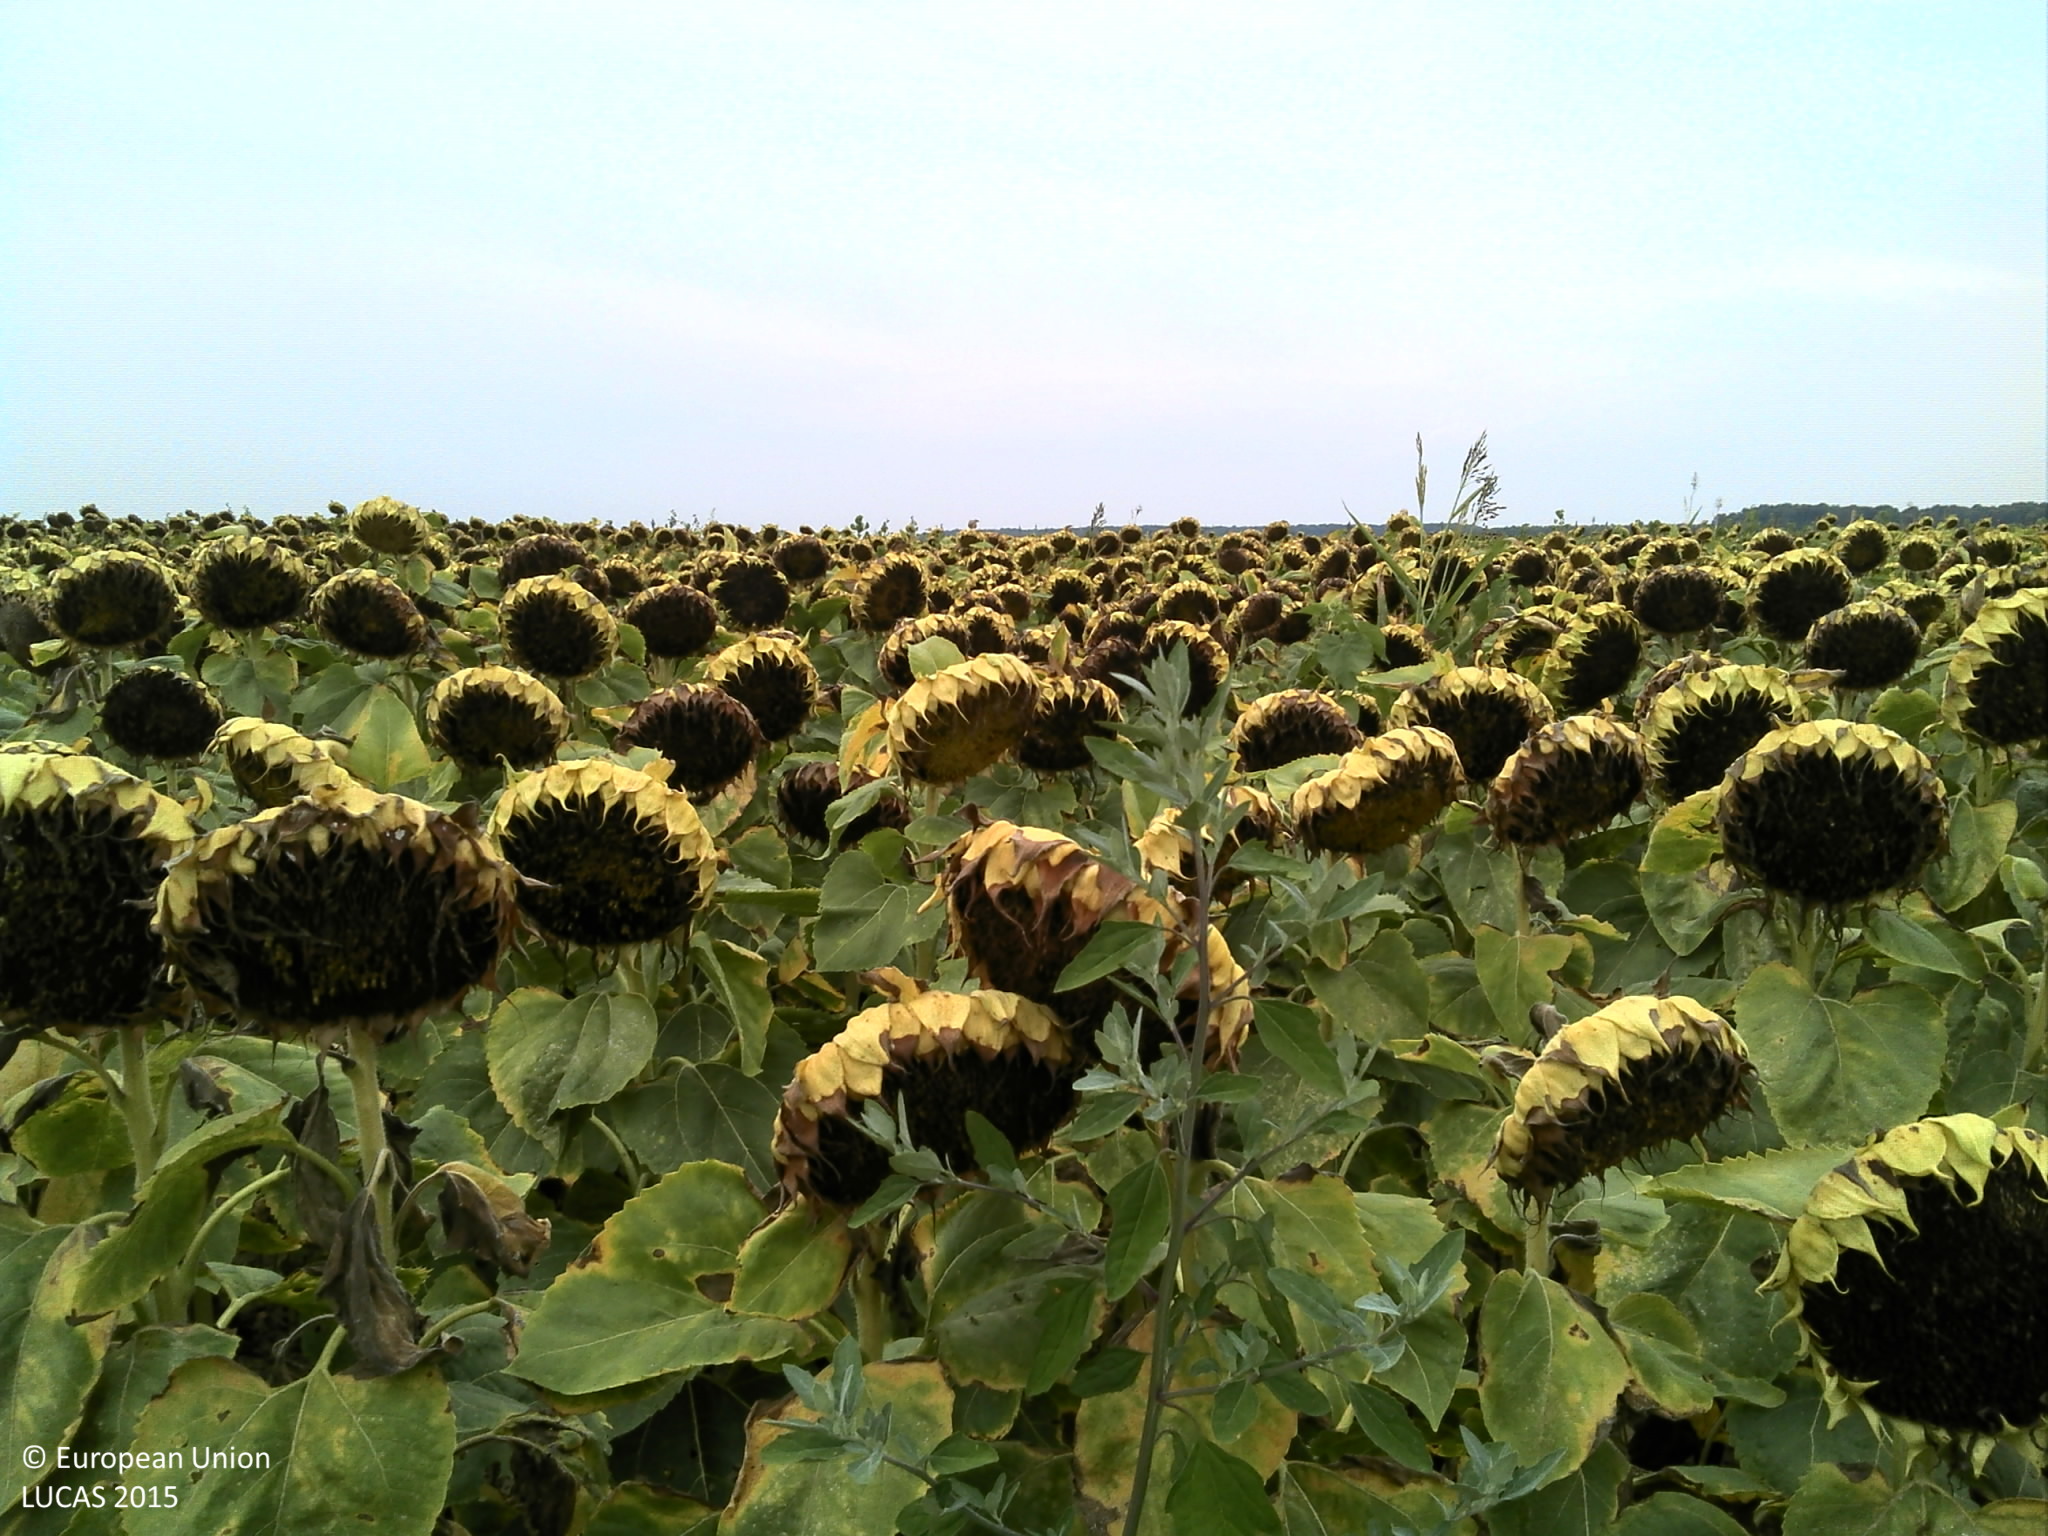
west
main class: Cropland
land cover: Sunflower
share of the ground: > 75 %
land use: Agriculture (excluding fallow land and kitchen gardens)
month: August
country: HR
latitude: 45.4681
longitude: 18.5119
